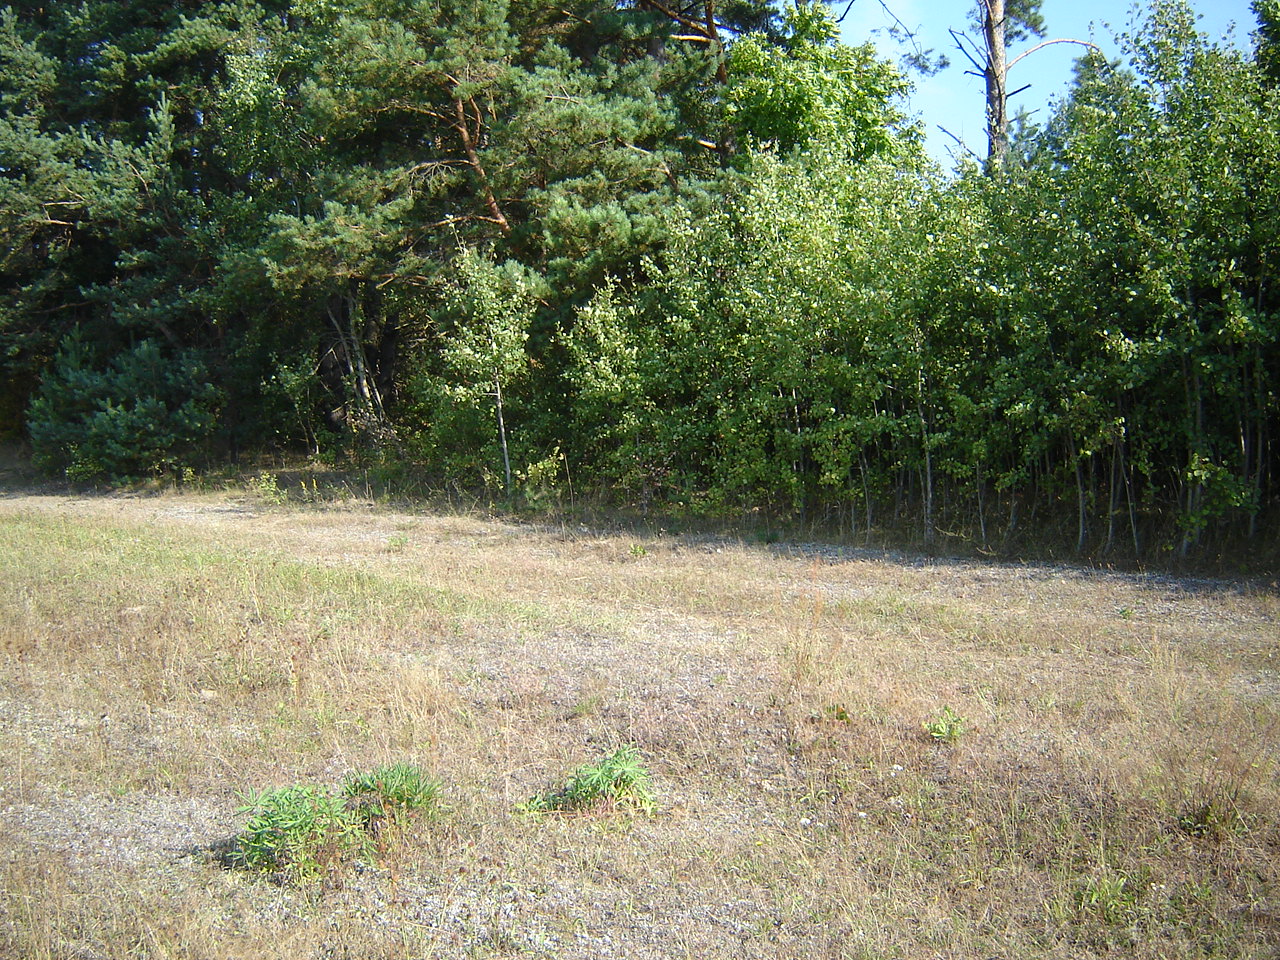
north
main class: Grassland
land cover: Grassland without tree/shrub cover
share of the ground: > 75 %
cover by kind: herbaceous plants 100 %
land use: Agriculture (excluding fallow land and kitchen gardens)
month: August
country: LT
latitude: 54.6147
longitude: 24.9001
